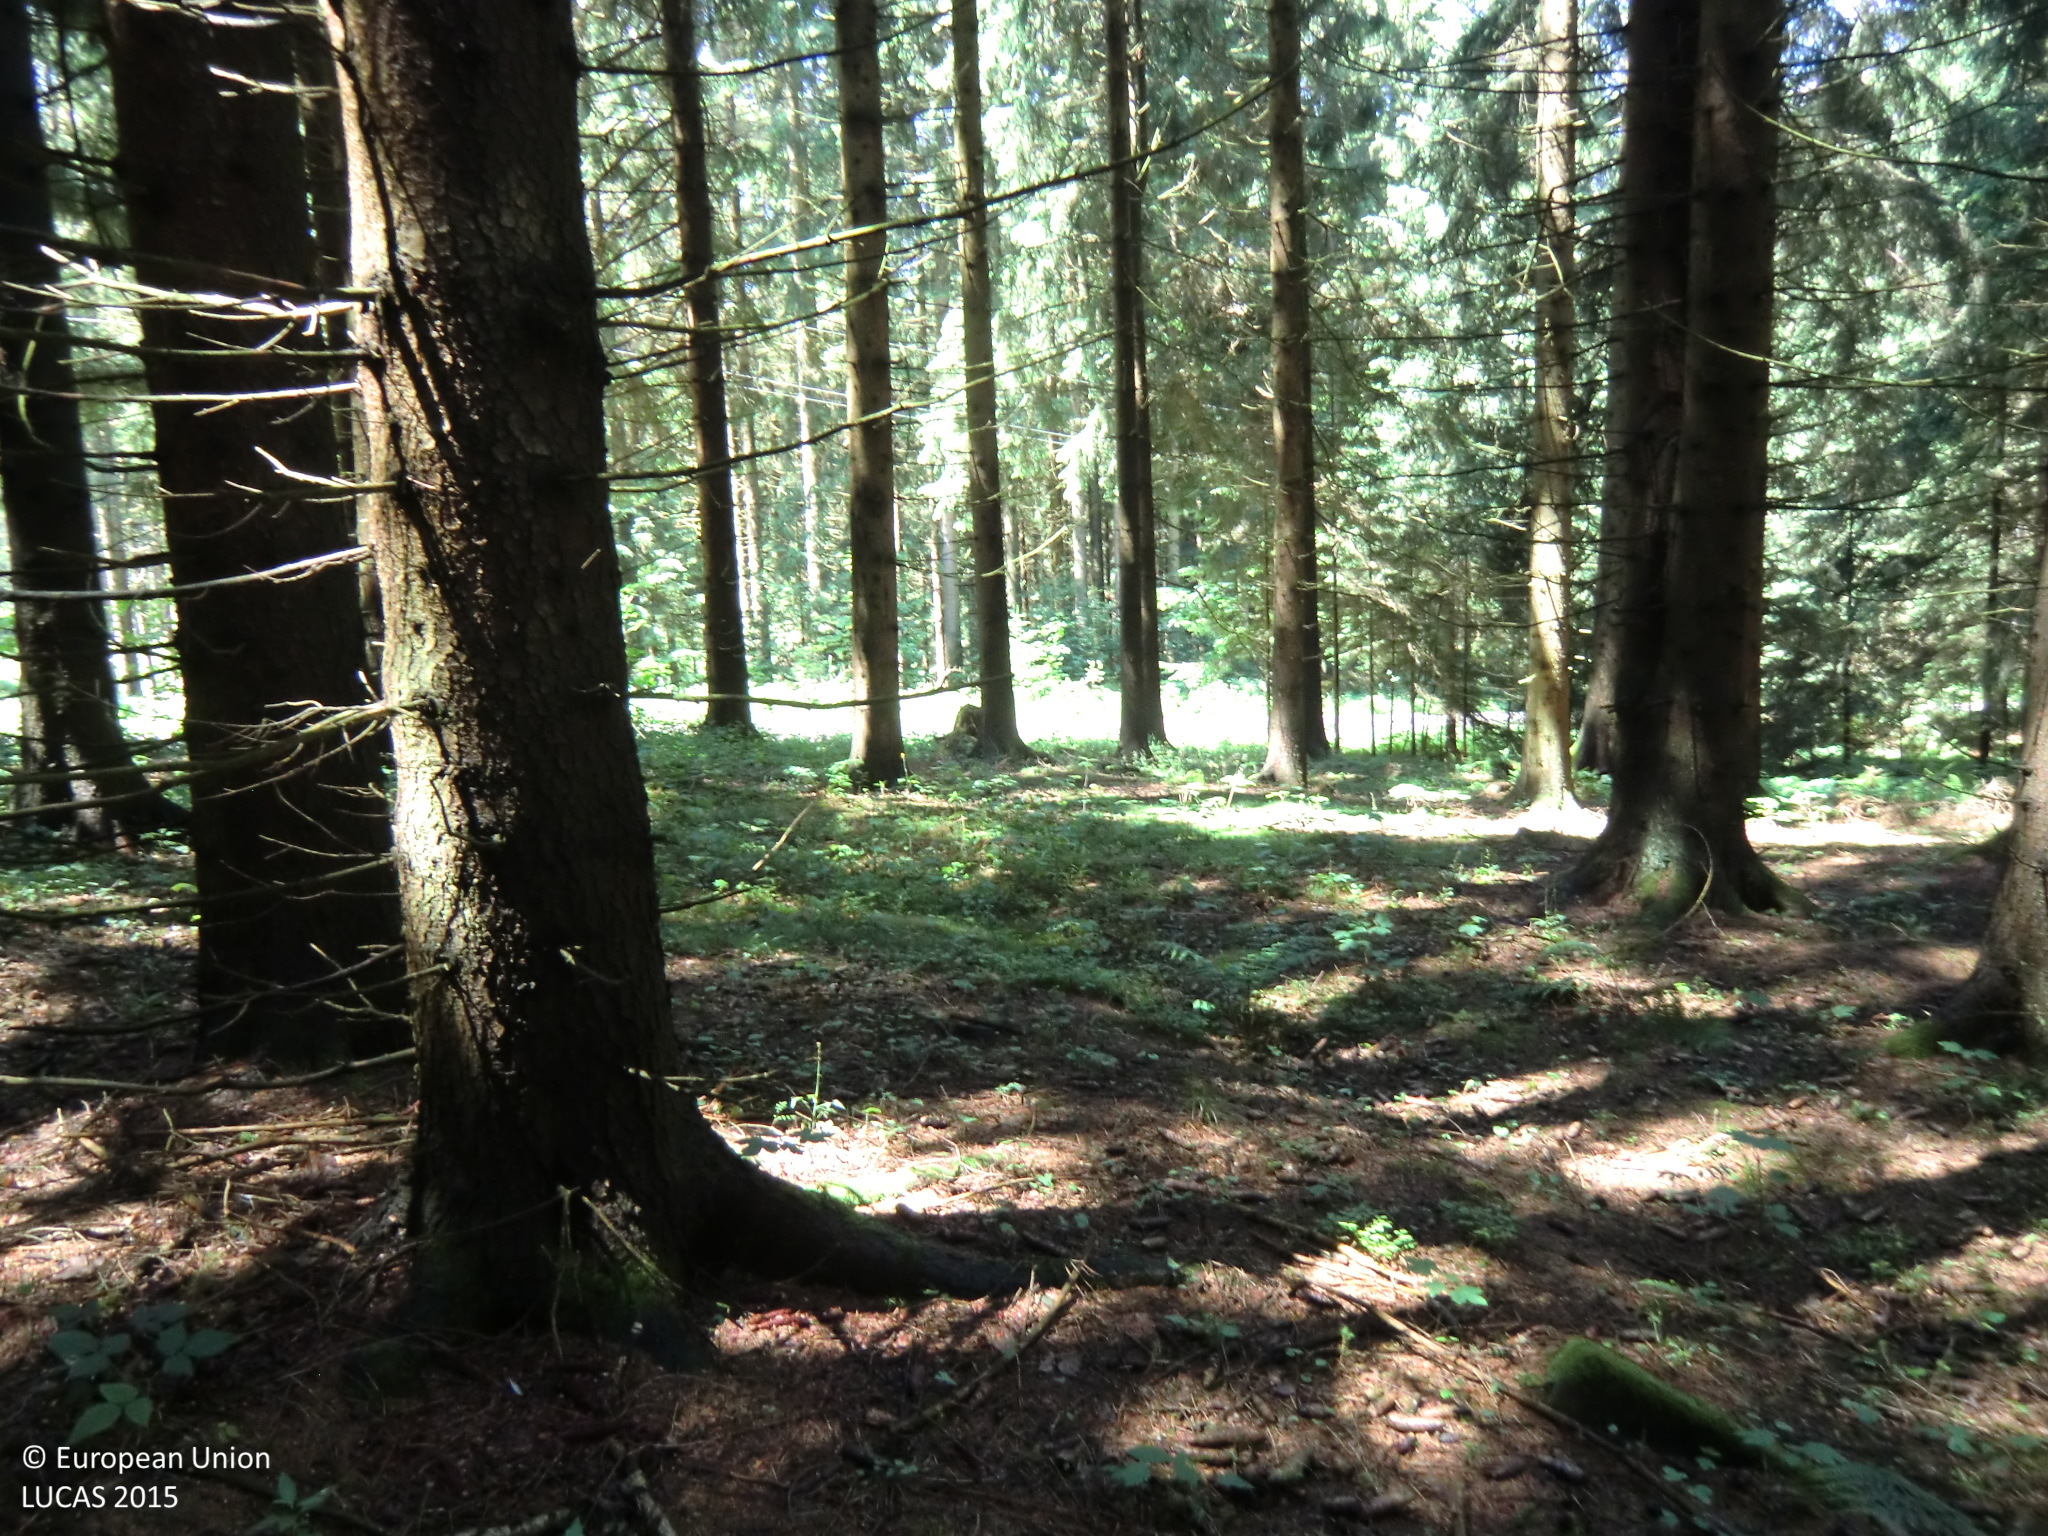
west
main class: Woodland
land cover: Spruce dominated coniferous woodland
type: hemiboreal forest and nemoral coniferous forest and mixed broadleaved-coniferous forest
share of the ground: > 75 %
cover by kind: coniferous forest trees 90 %, herbaceous plants 5 %, unconsolidated bare surface 5 %
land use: Forestry
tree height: > 5 m
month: June
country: AT
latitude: 48.5603
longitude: 14.5943
